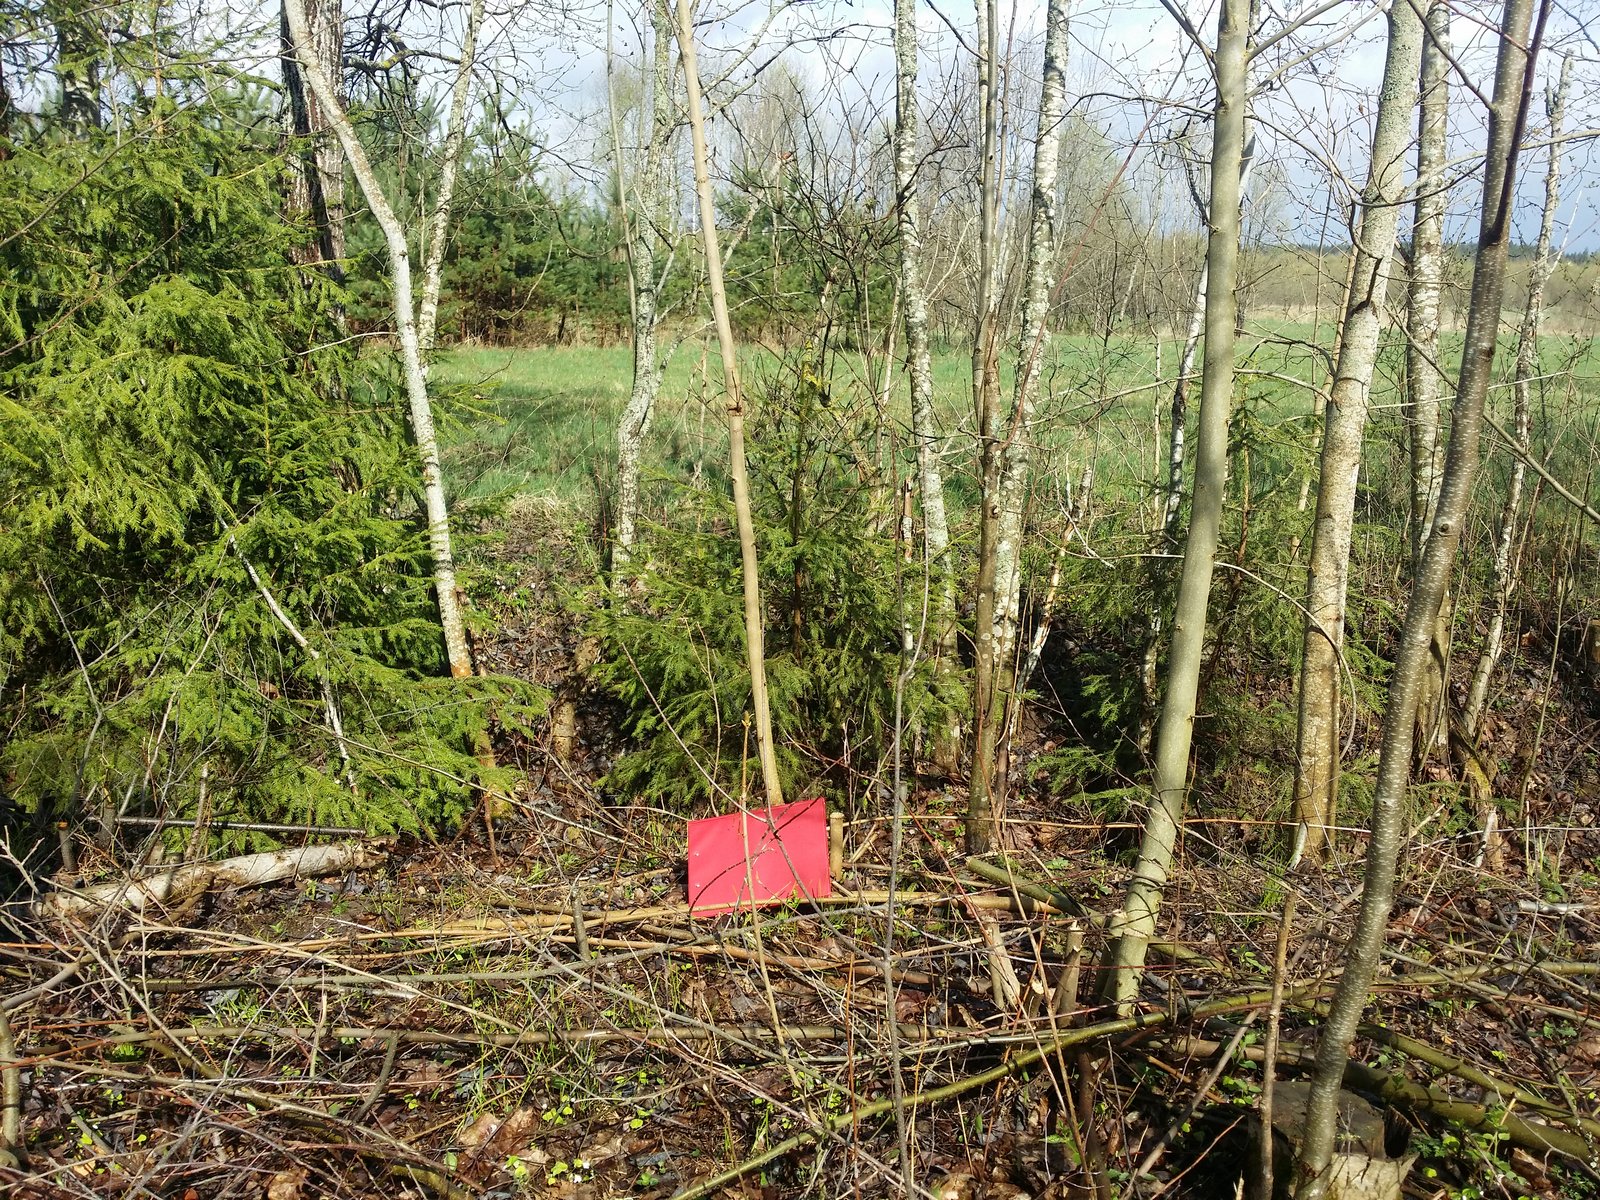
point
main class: Woodland
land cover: Broadleaved woodland
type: non-riverine alder, birch or aspen forest
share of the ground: 50 - 75 %
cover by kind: broadleaved forest trees 70 %, herbaceous plants 30 %
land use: Forestry
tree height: < 5 m
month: May
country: LV
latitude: 57.3999
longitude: 25.9881
